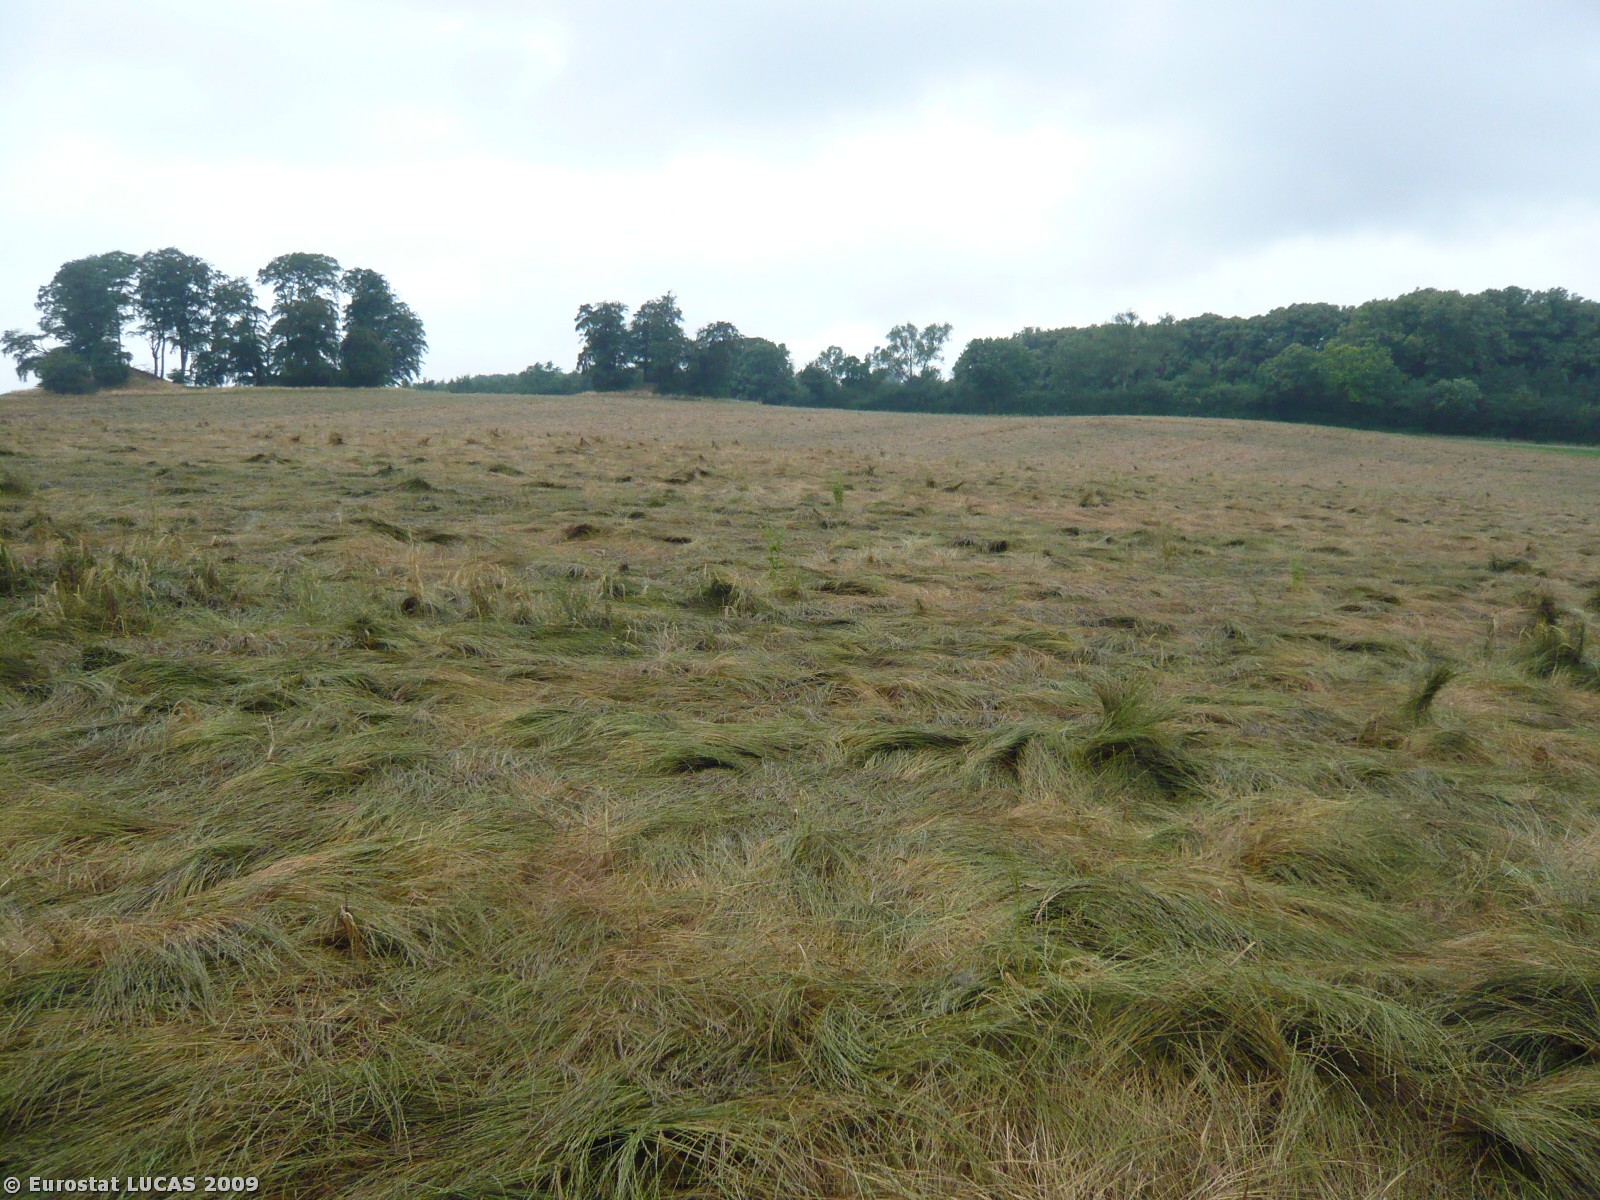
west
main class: Cropland
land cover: Temporary grasslands
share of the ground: > 75 %
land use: Agriculture (excluding fallow land and kitchen gardens)
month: July
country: DK
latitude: 55.6709
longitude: 11.8586
